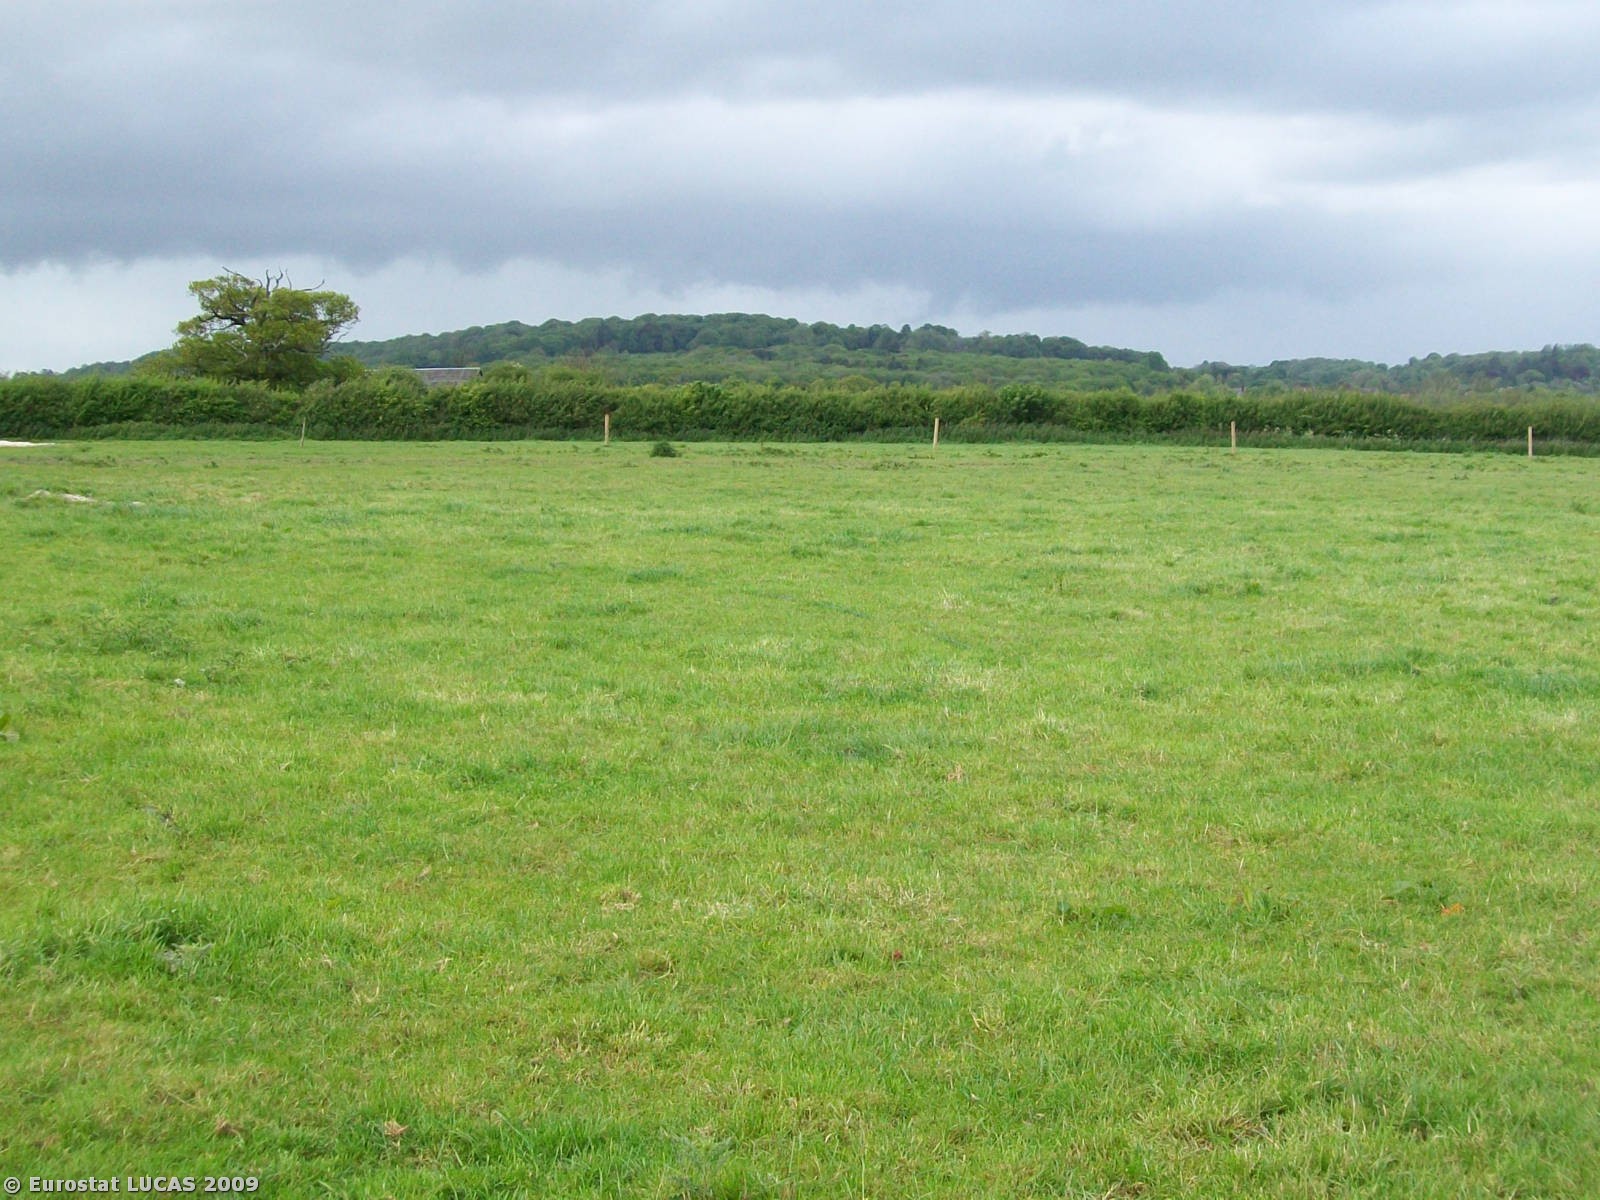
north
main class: Grassland
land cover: Grassland without tree/shrub cover
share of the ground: > 75 %
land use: Agriculture (excluding fallow land and kitchen gardens)
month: May
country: GB
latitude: 51.0569
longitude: -2.1739
